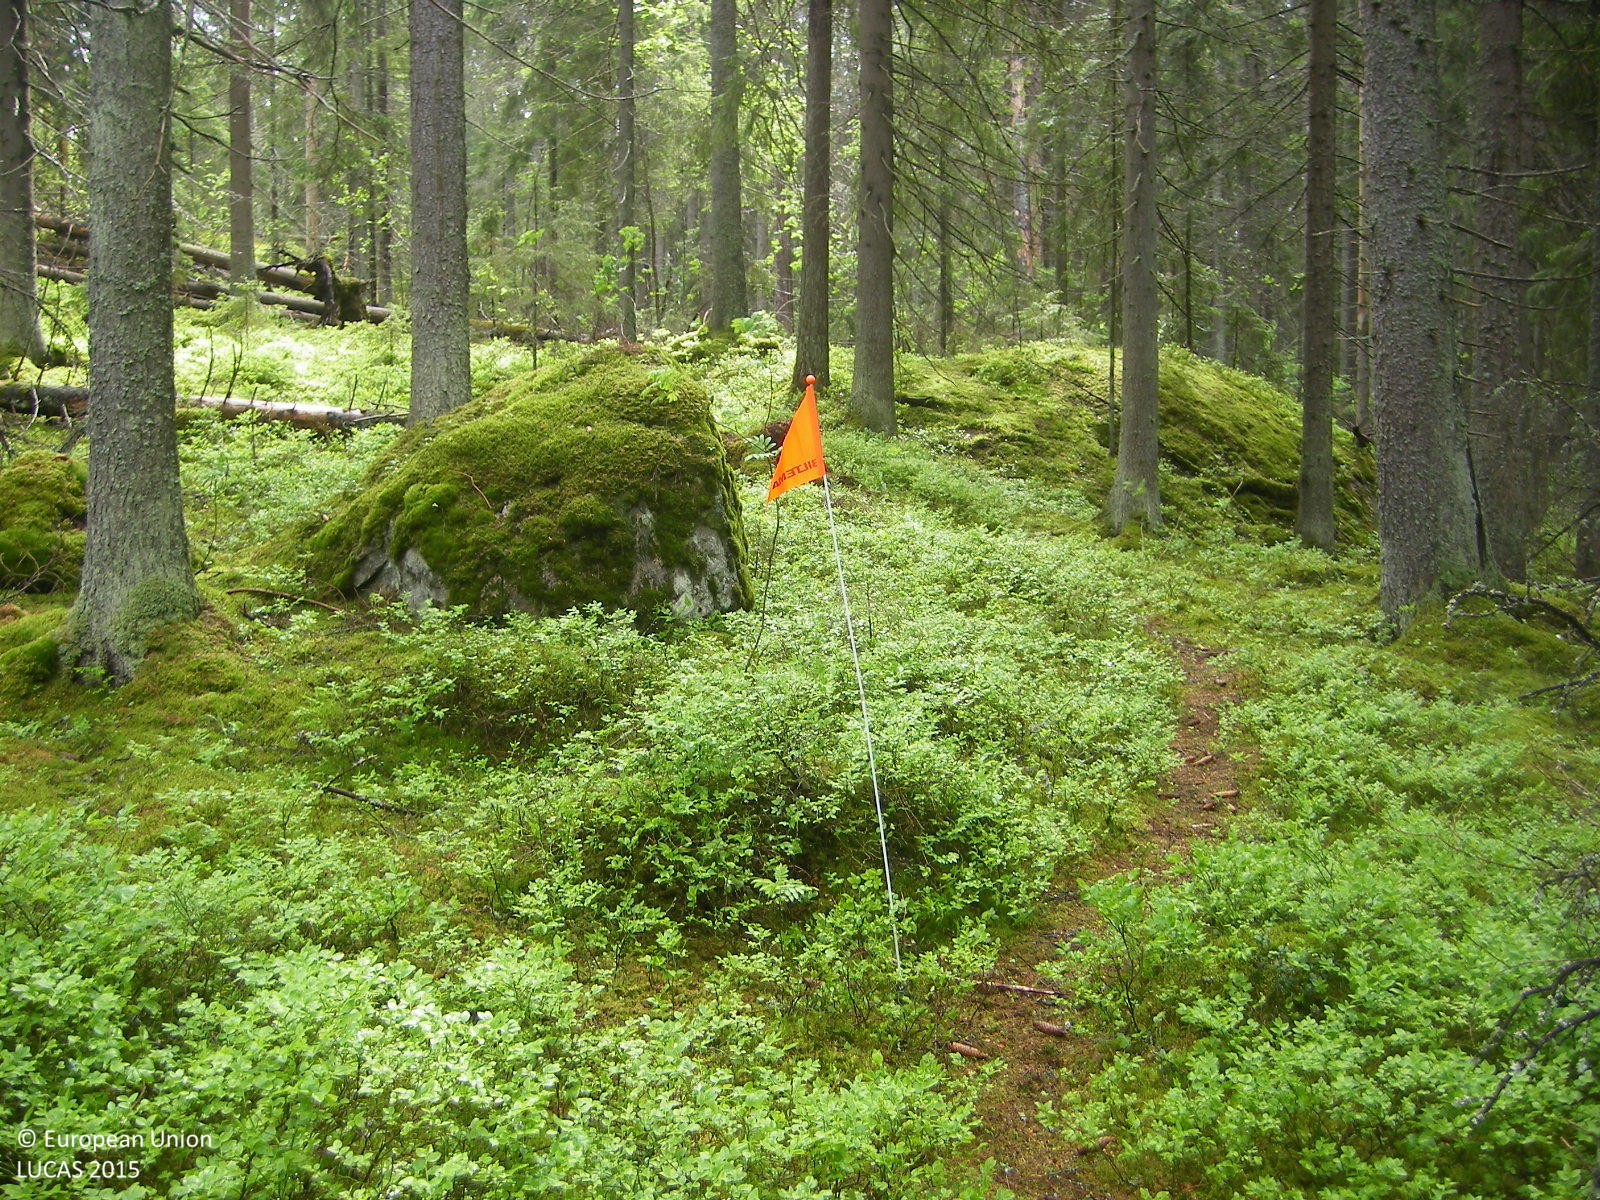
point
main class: Woodland
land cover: Spruce dominated coniferous woodland
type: boreal forest
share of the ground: > 75 %
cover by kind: coniferous forest trees 75 %, shrubs 15 %, lichens and mosses 10 %
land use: Amenities, museums, leisure
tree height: > 5 m
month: June
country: FI
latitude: 60.3237
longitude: 24.6881
